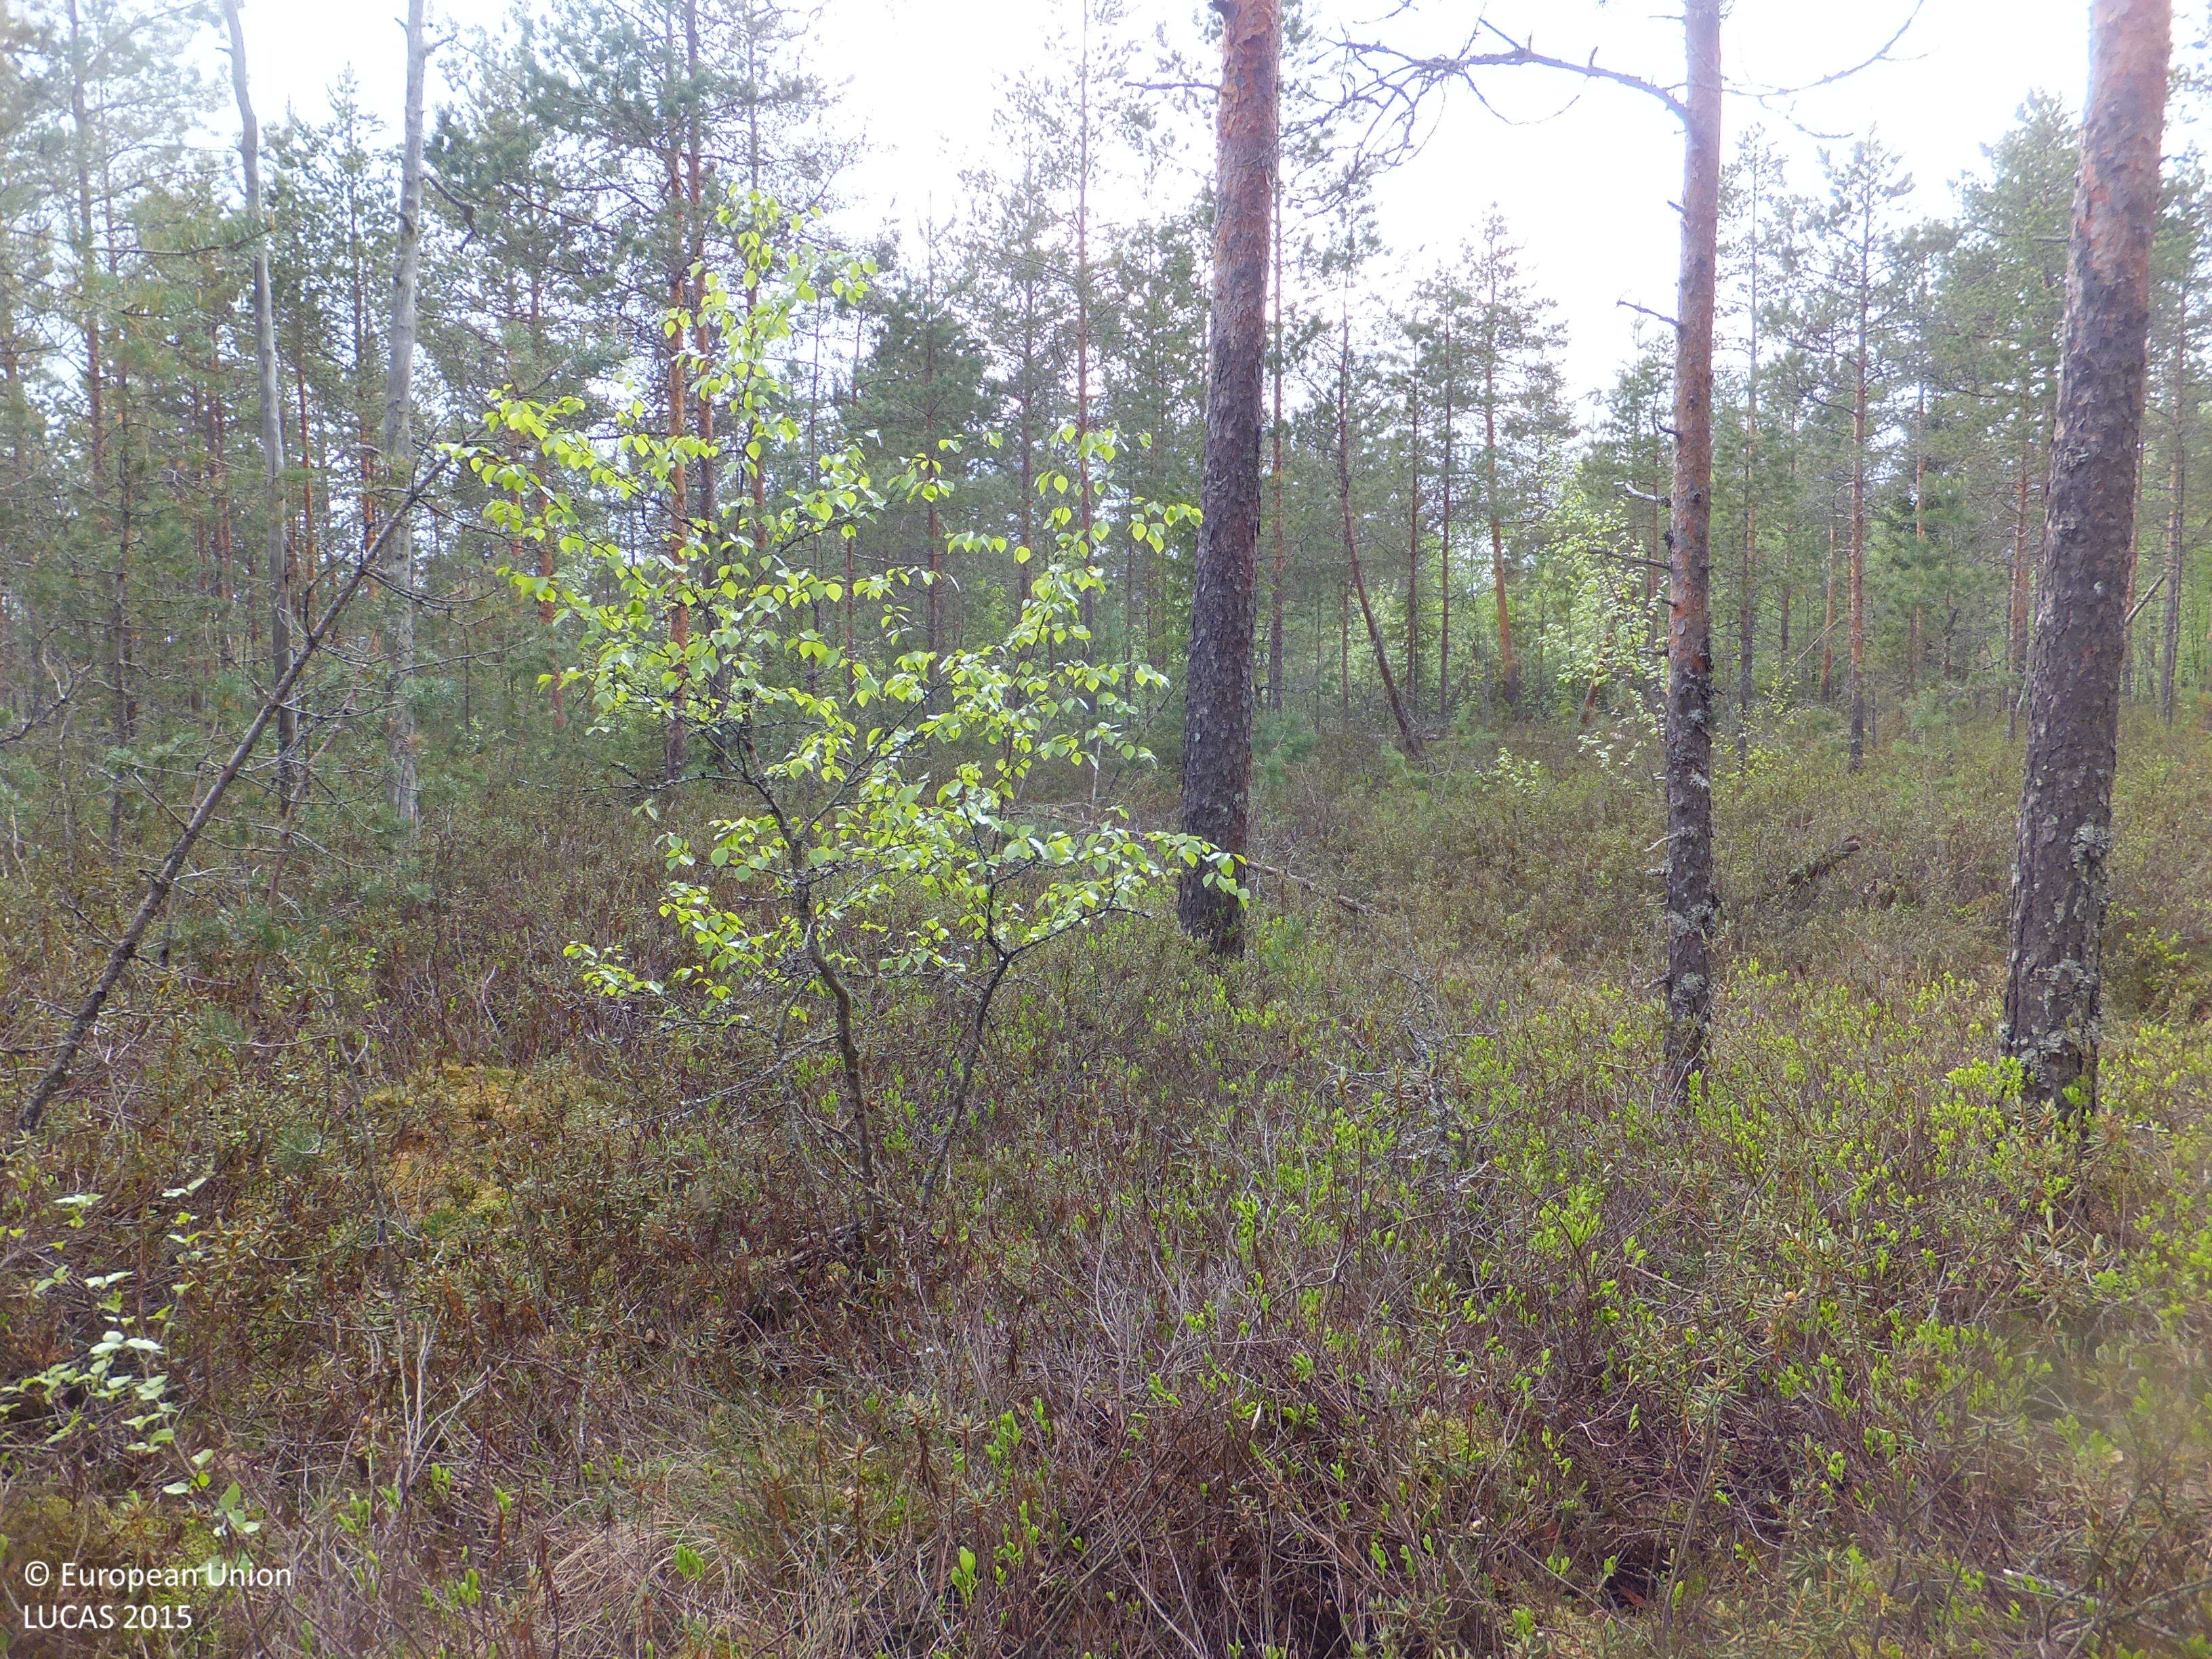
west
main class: Woodland
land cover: Pine dominated coniferous woodland
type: boreal forest
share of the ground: > 75 %
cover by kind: coniferous forest trees 80 %, shrubs 10 %, broadleaved forest trees 5 %, lichens and mosses 5 %
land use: Forestry
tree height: > 5 m
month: June
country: FI
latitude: 63.5470
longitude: 23.2365
